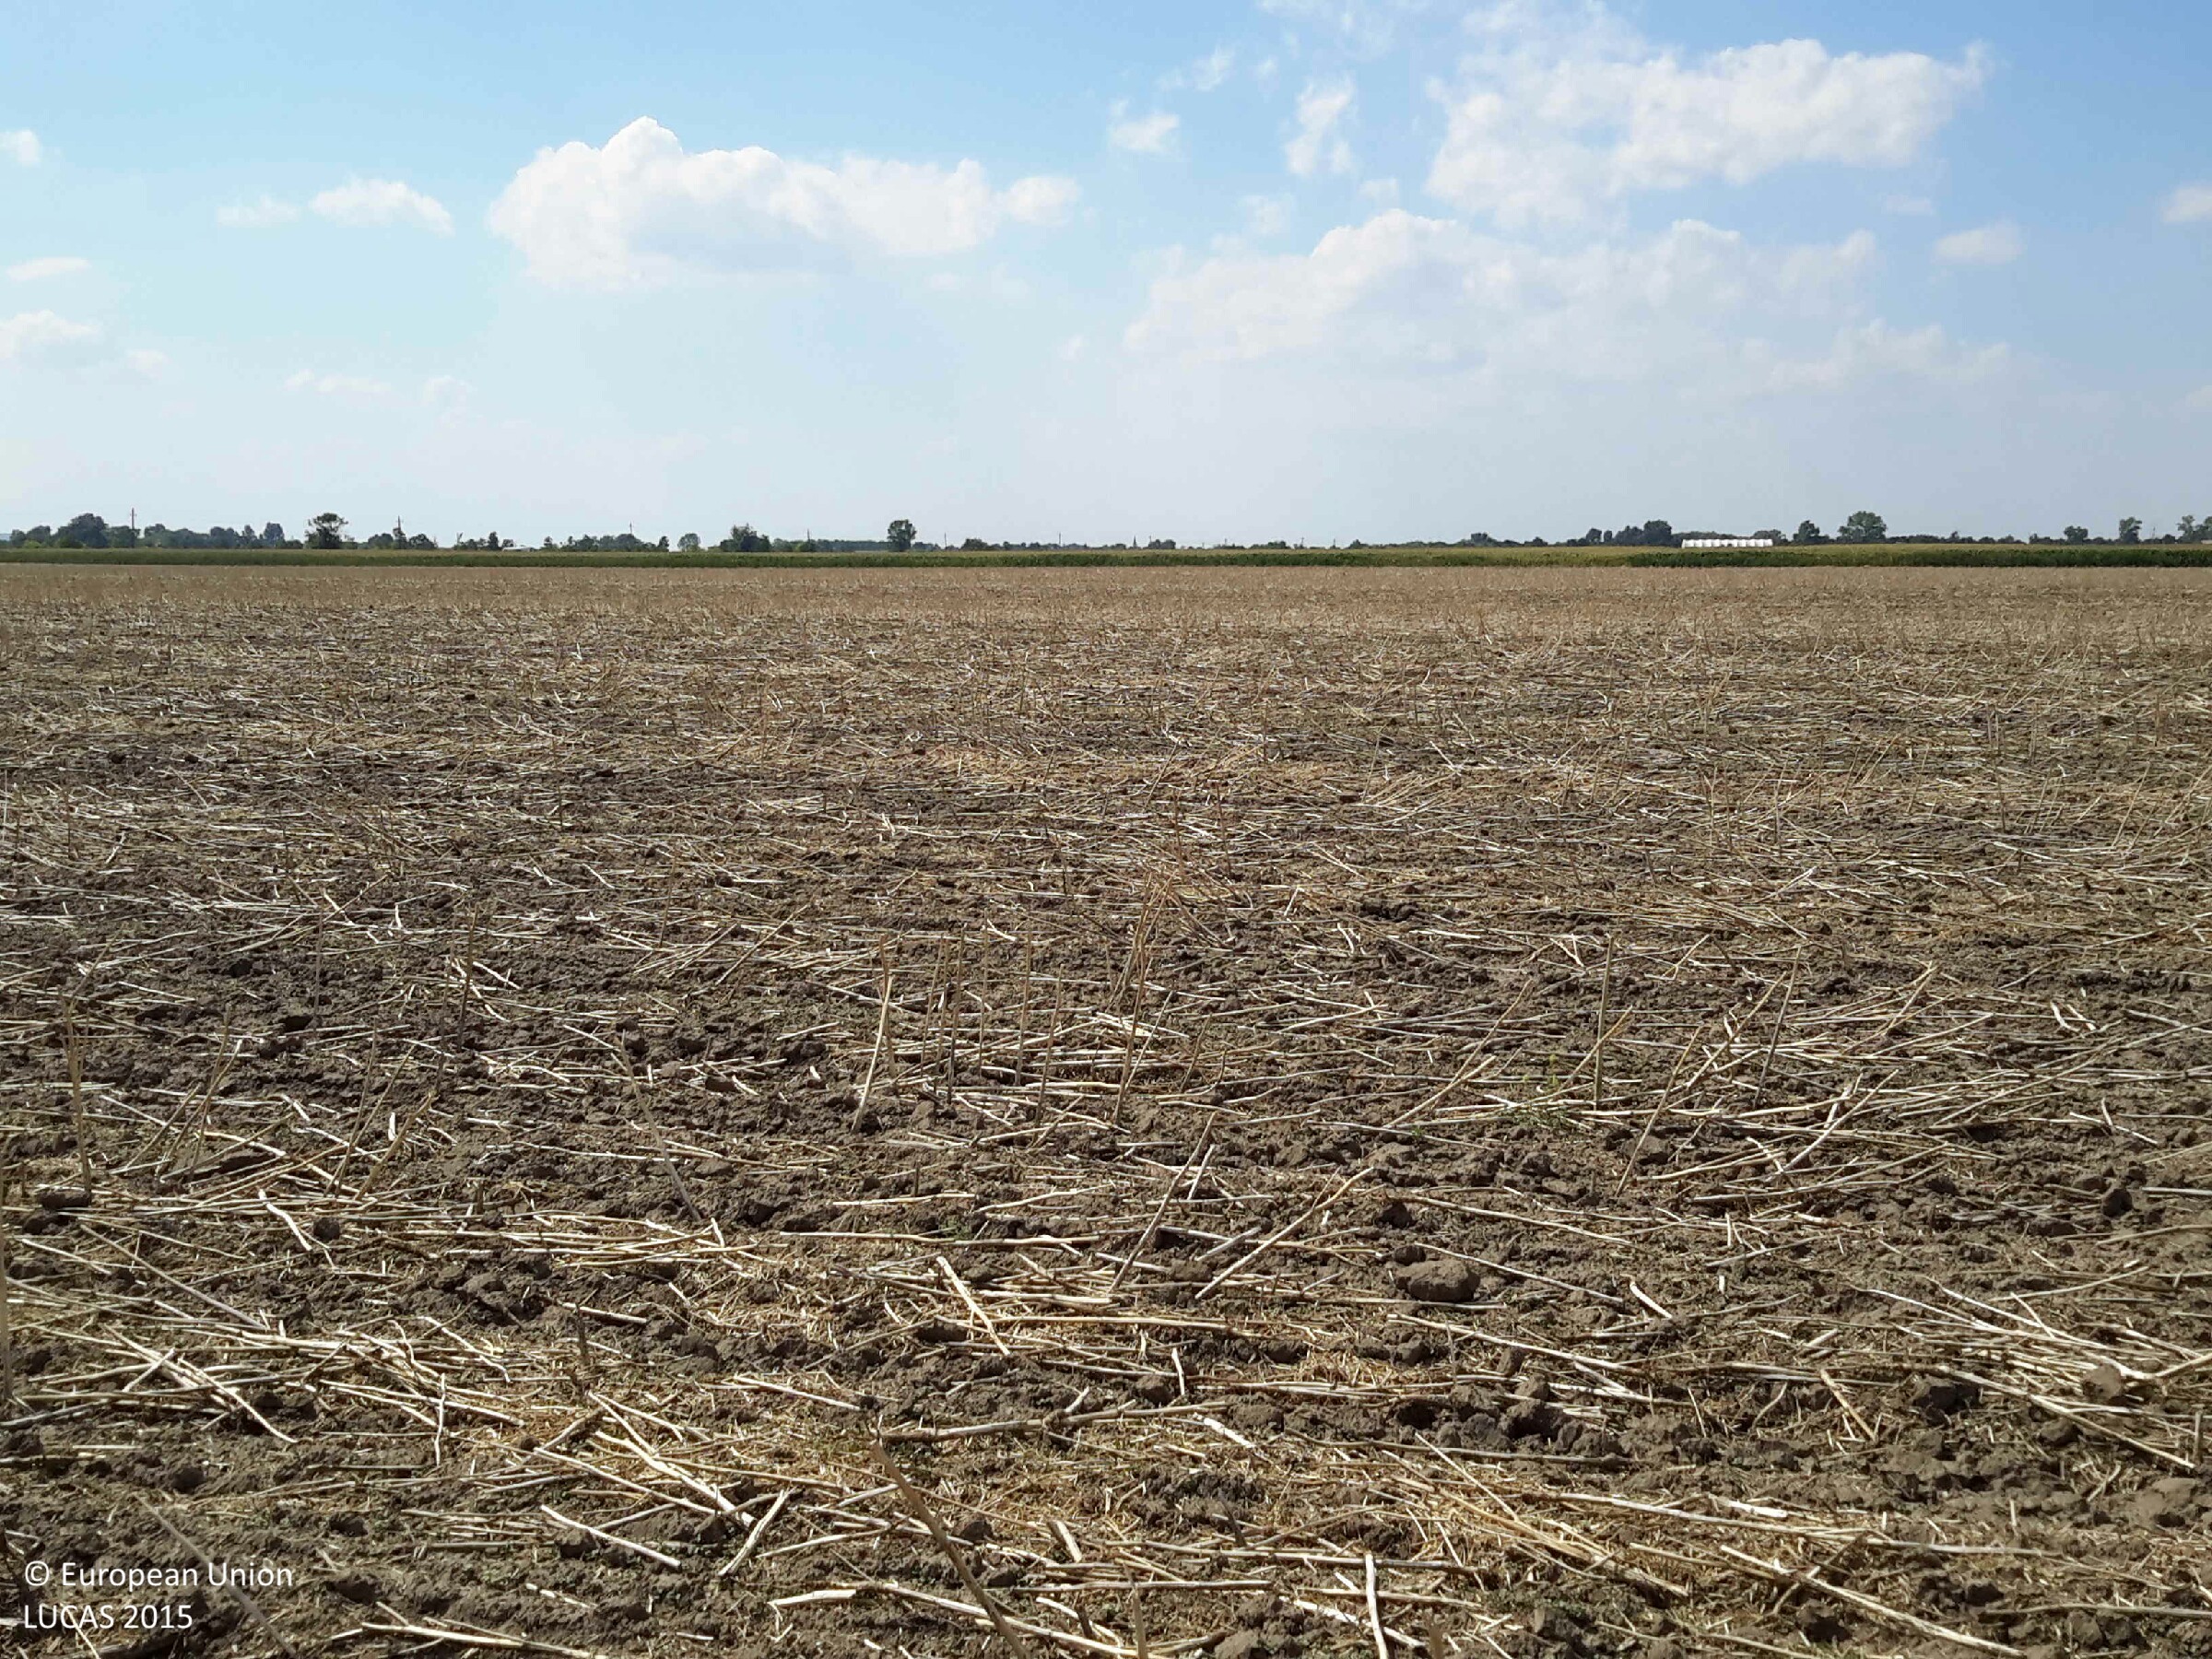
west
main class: Cropland
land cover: Rape and turnip rape
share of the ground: 50 - 75 %
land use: Agriculture (excluding fallow land and kitchen gardens)
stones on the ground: < 10 %
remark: Harvested field
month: July
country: HU
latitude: 47.6003
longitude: 17.8441
